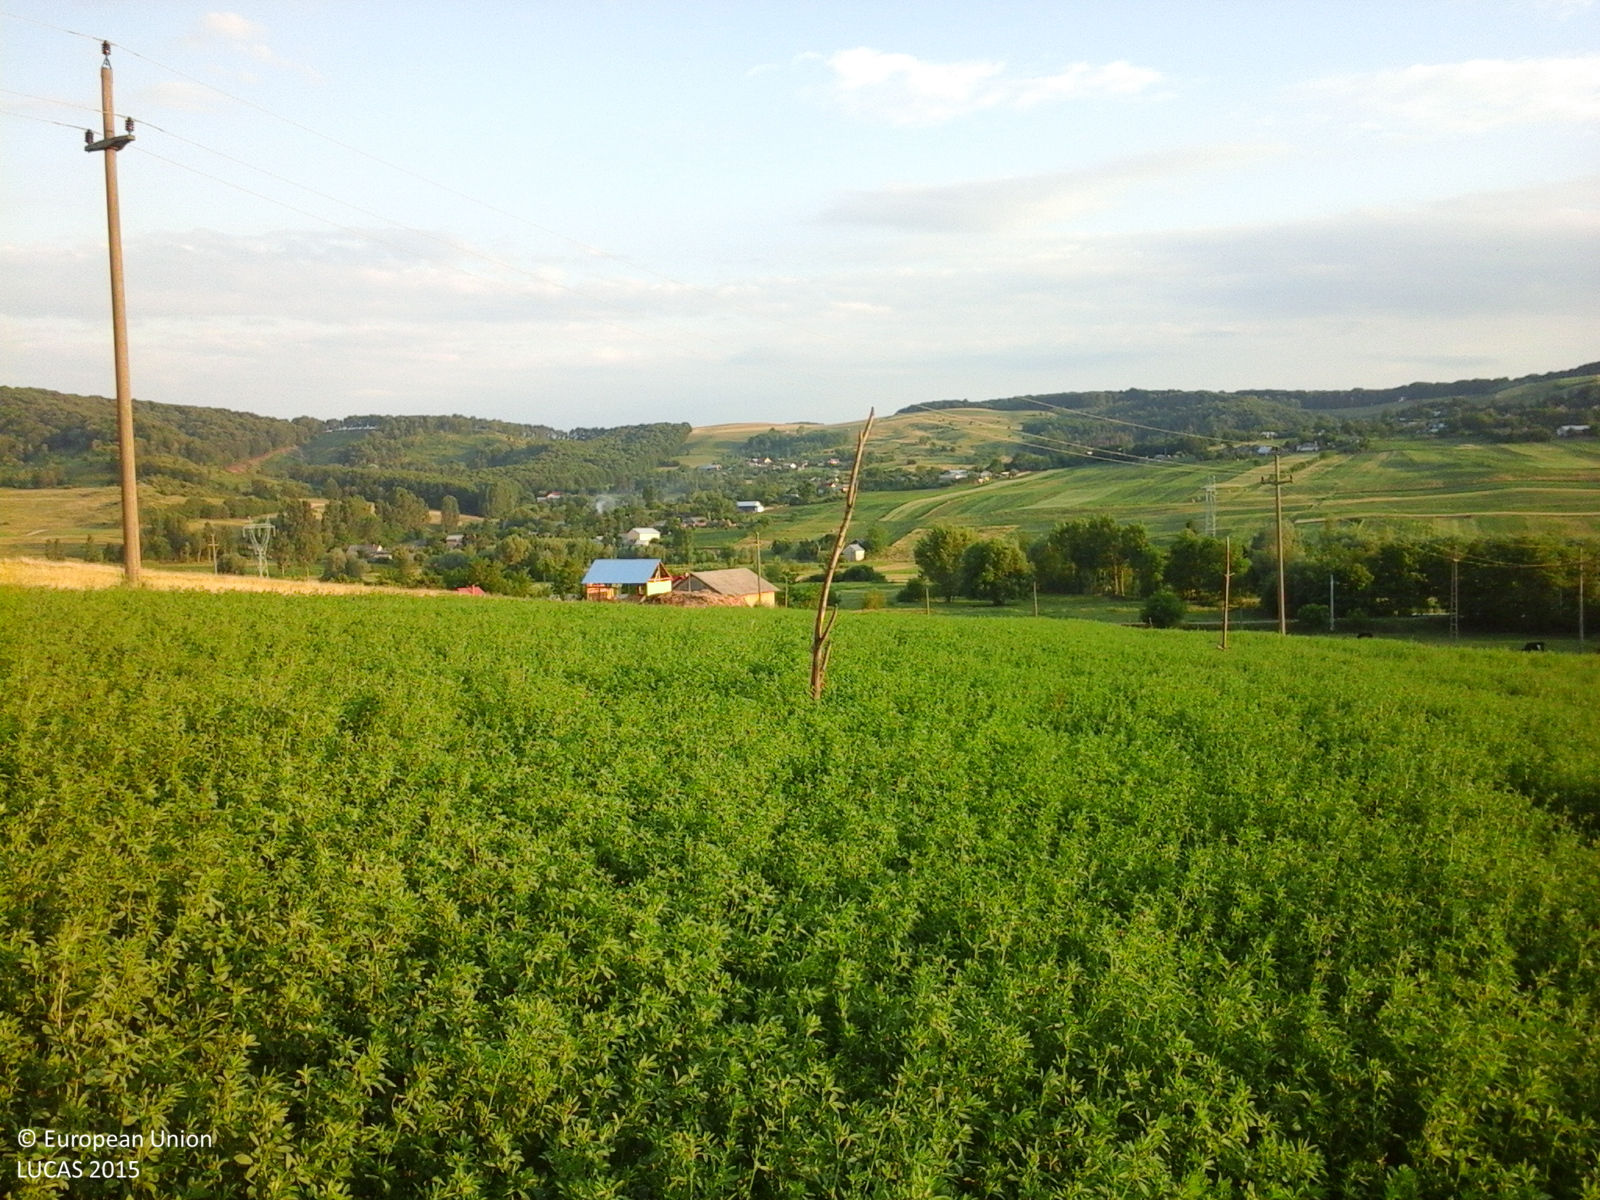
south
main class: Cropland
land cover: Lucerne
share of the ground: > 75 %
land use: Agriculture (excluding fallow land and kitchen gardens)
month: June
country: RO
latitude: 47.5117
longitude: 26.4325
